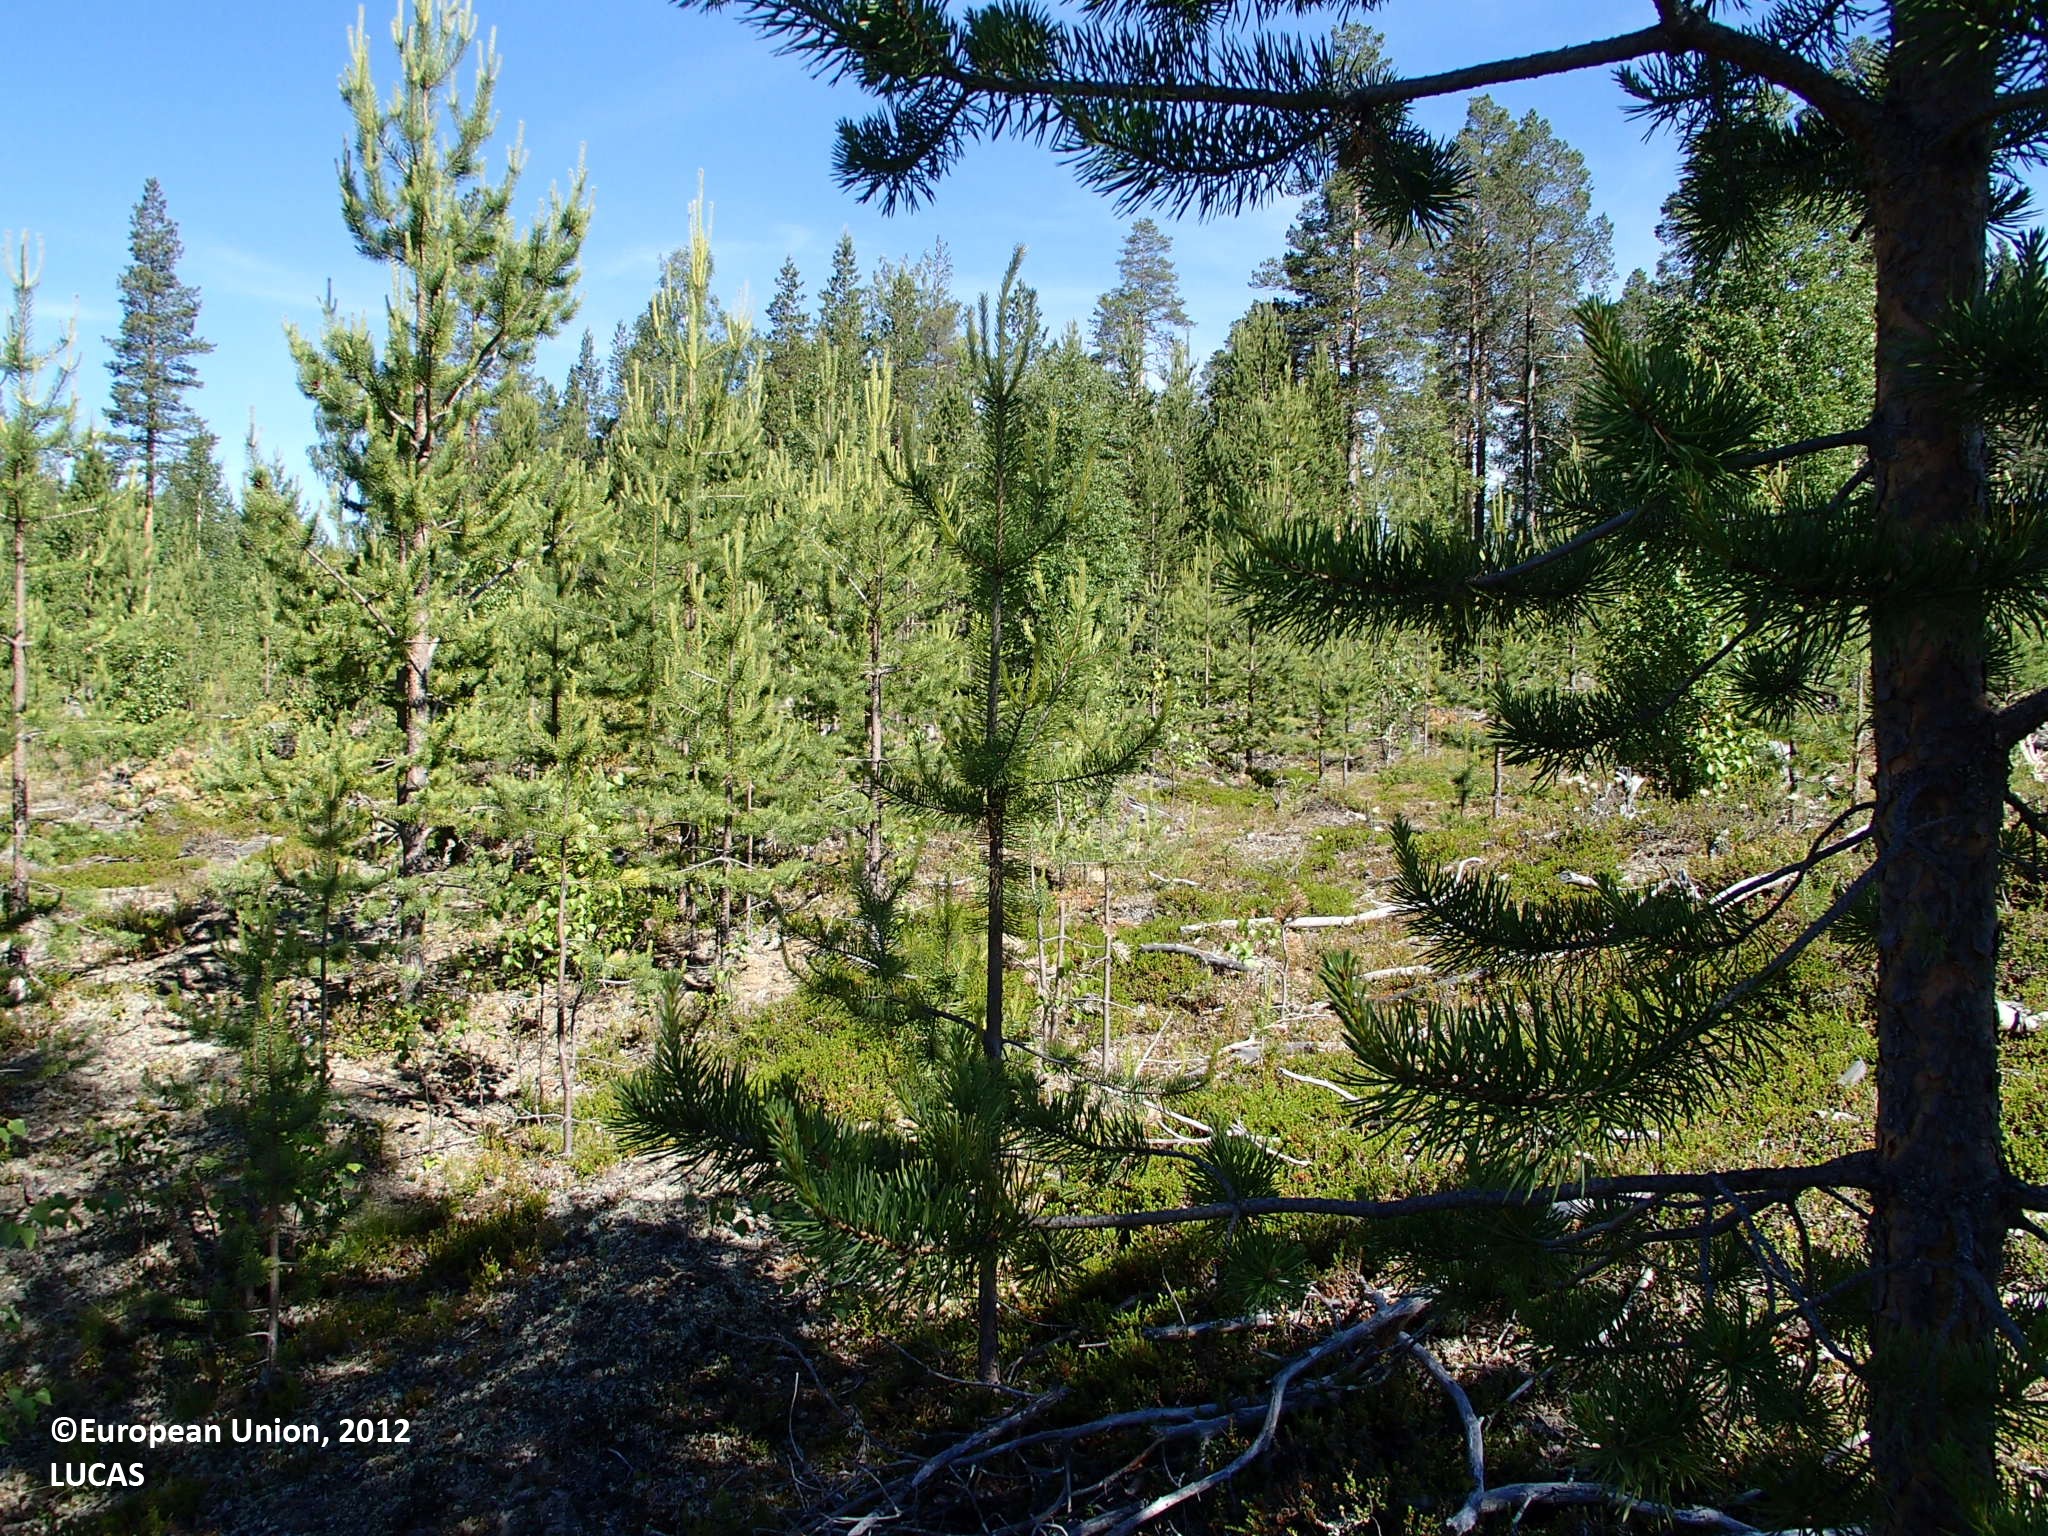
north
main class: Woodland
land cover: Other mixed woodland
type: boreal forest
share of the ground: 10 - 25 %
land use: Forestry
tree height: > 5 m
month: July
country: FI
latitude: 67.1153
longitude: 26.6497
